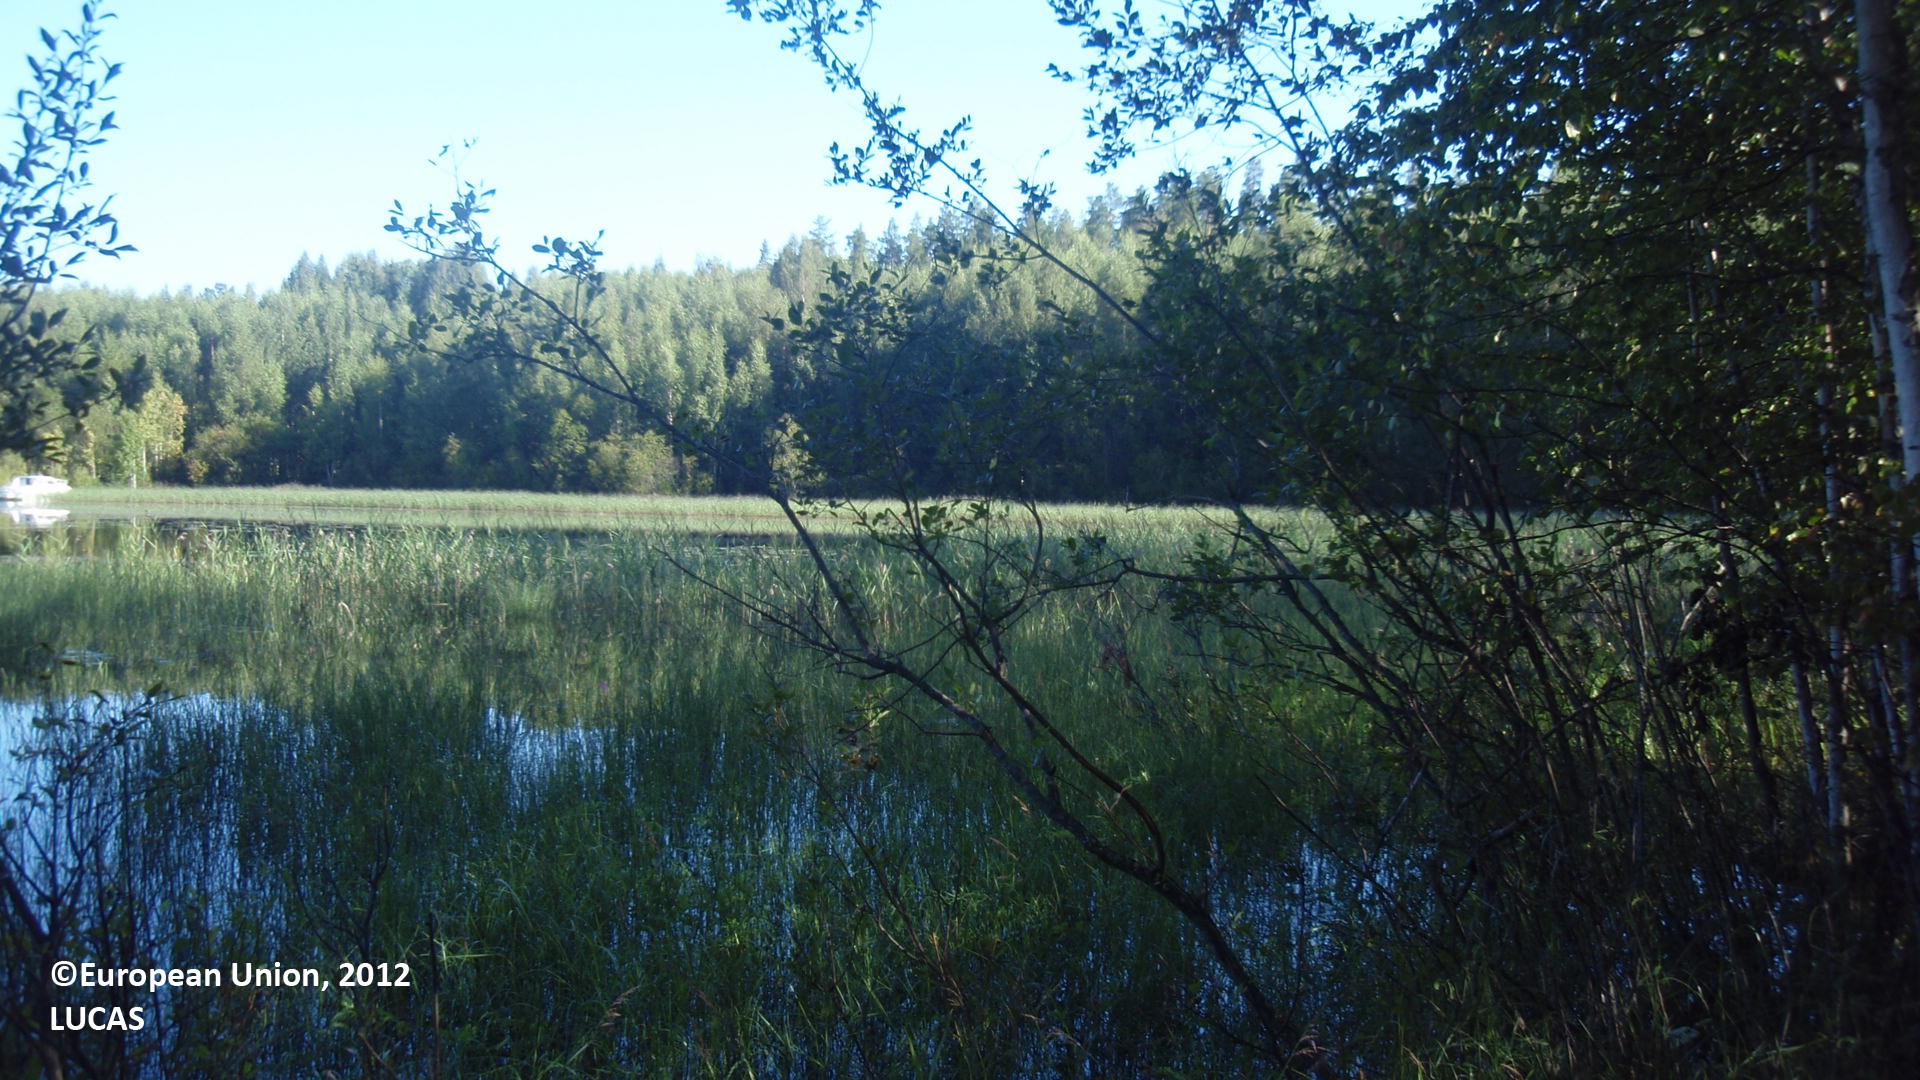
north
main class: Woodland
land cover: Broadleaved woodland
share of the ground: 50 - 75 %
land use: Forestry
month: August
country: FI
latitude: 61.5315
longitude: 27.8473
